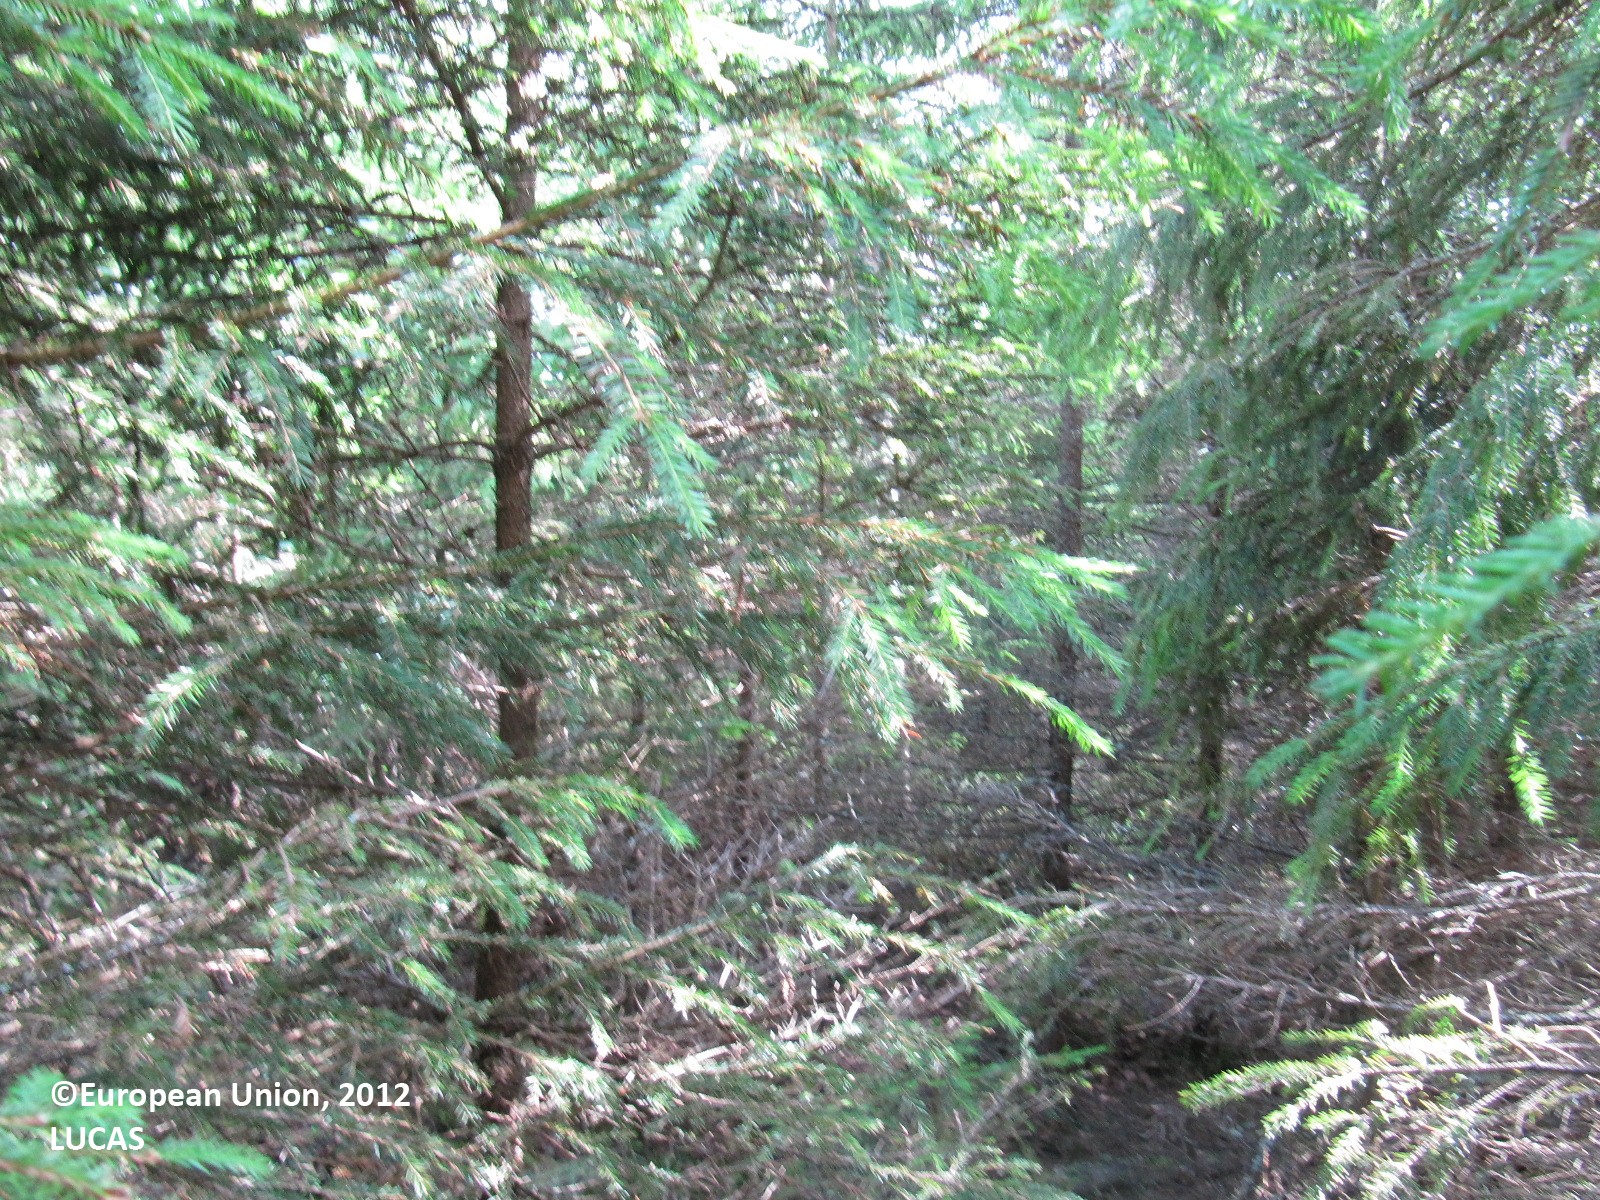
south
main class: Woodland
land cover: Spruce dominated mixed woodland
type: boreal forest
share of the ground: > 75 %
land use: Forestry
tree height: > 5 m
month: July
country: FI
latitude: 60.8569
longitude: 24.1417
